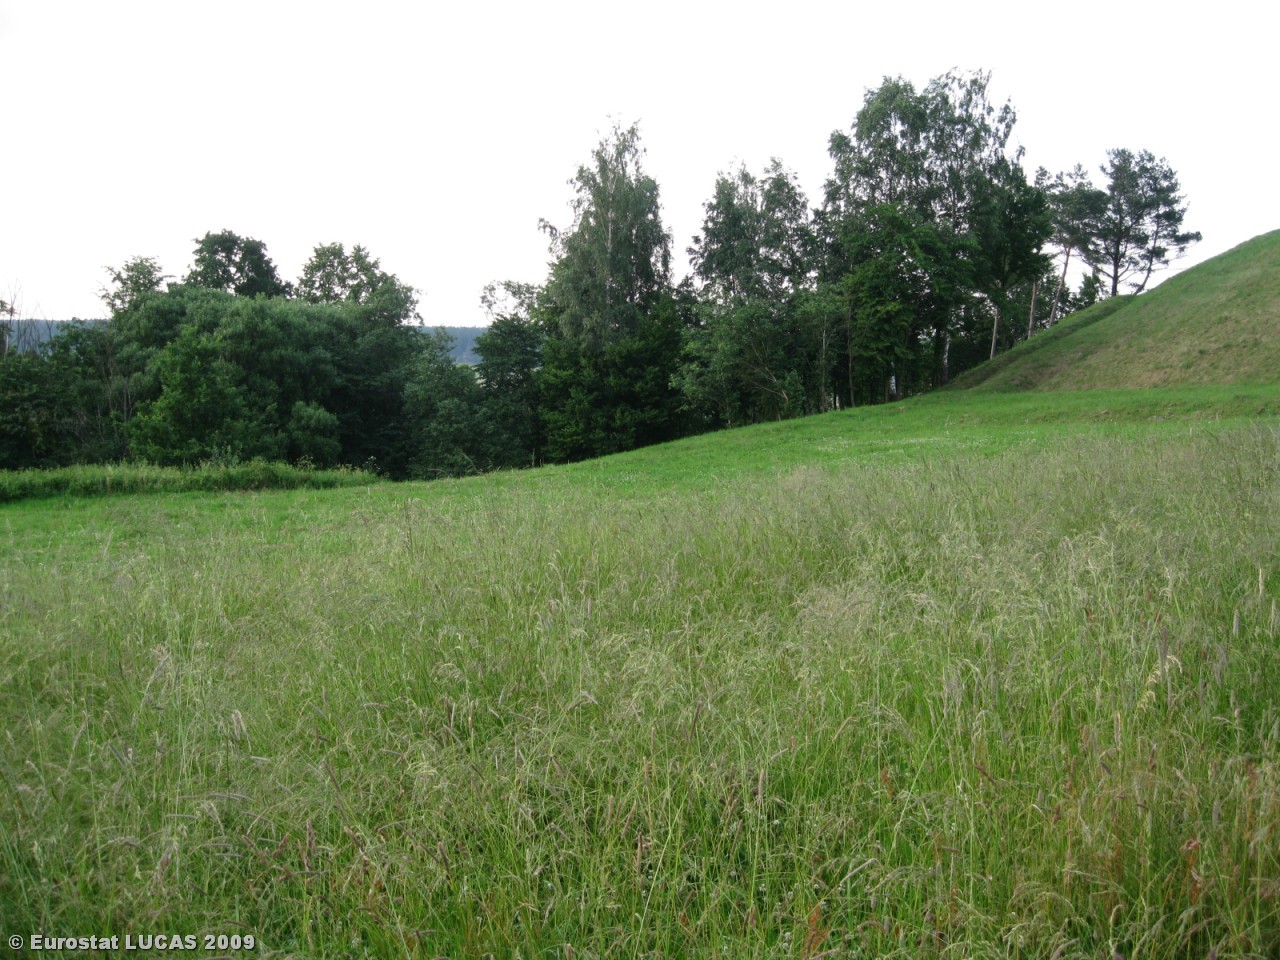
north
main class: Grassland
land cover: Grassland without tree/shrub cover
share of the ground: > 75 %
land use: Agriculture (excluding fallow land and kitchen gardens)
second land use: Amenities, museums, leisure
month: June
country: LT
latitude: 55.0500
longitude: 22.6336
